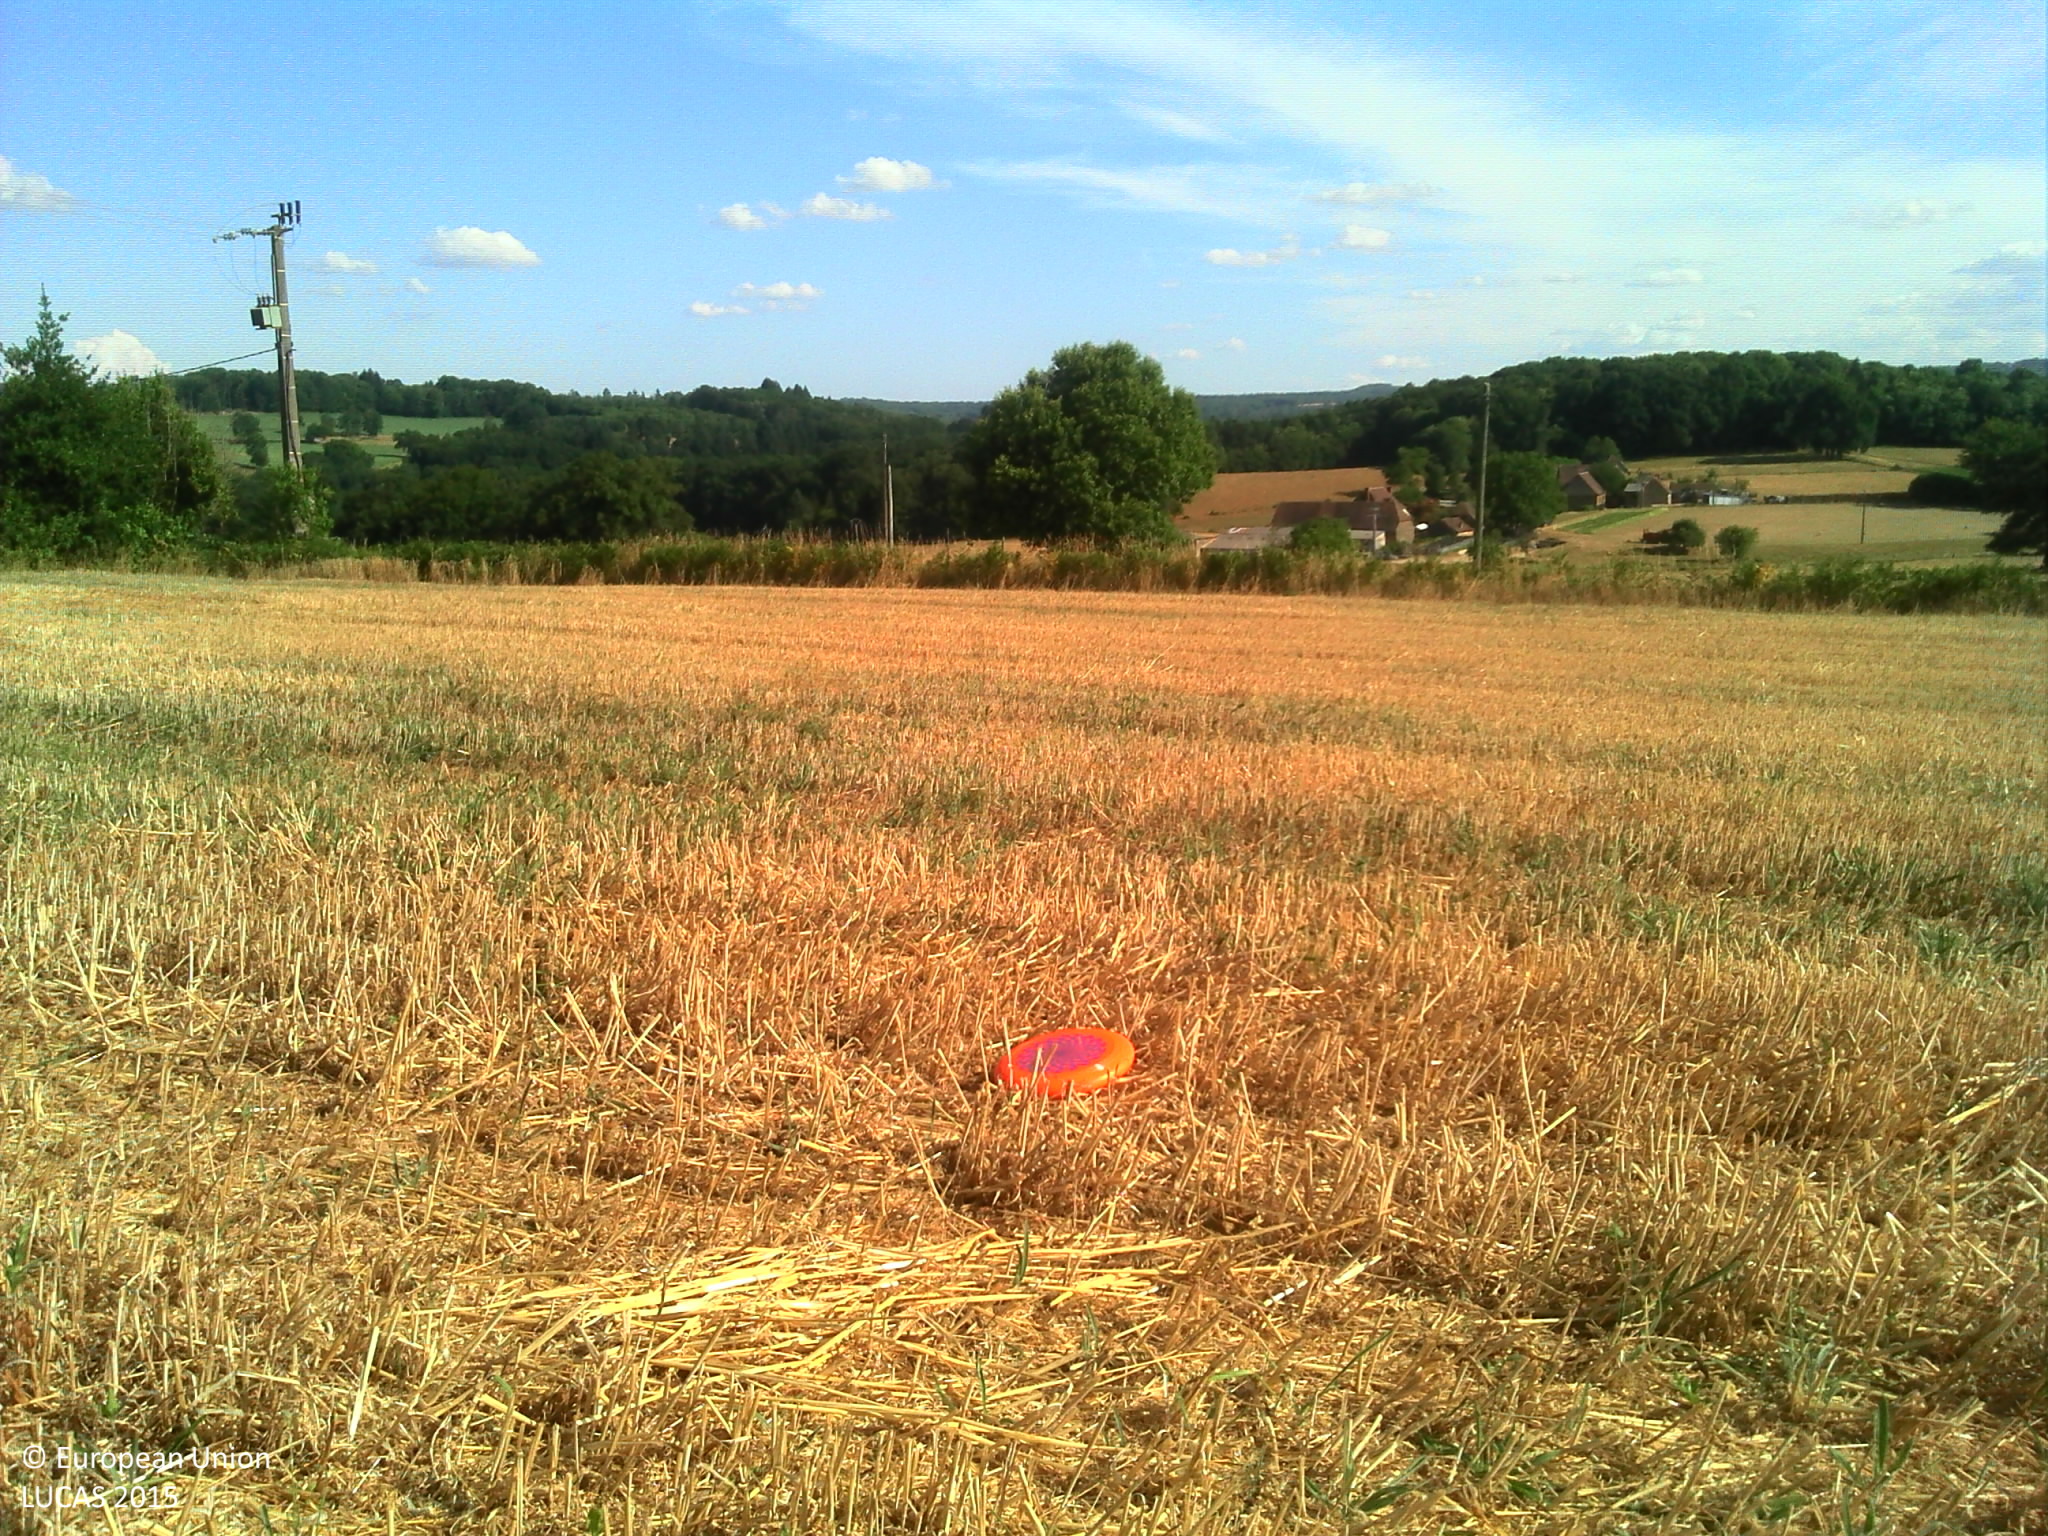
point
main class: Cropland
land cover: Mixed cereals for fodder
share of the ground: > 75 %
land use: Agriculture (excluding fallow land and kitchen gardens)
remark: Clear cut
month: July
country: FR
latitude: 45.6387
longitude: 1.3582
